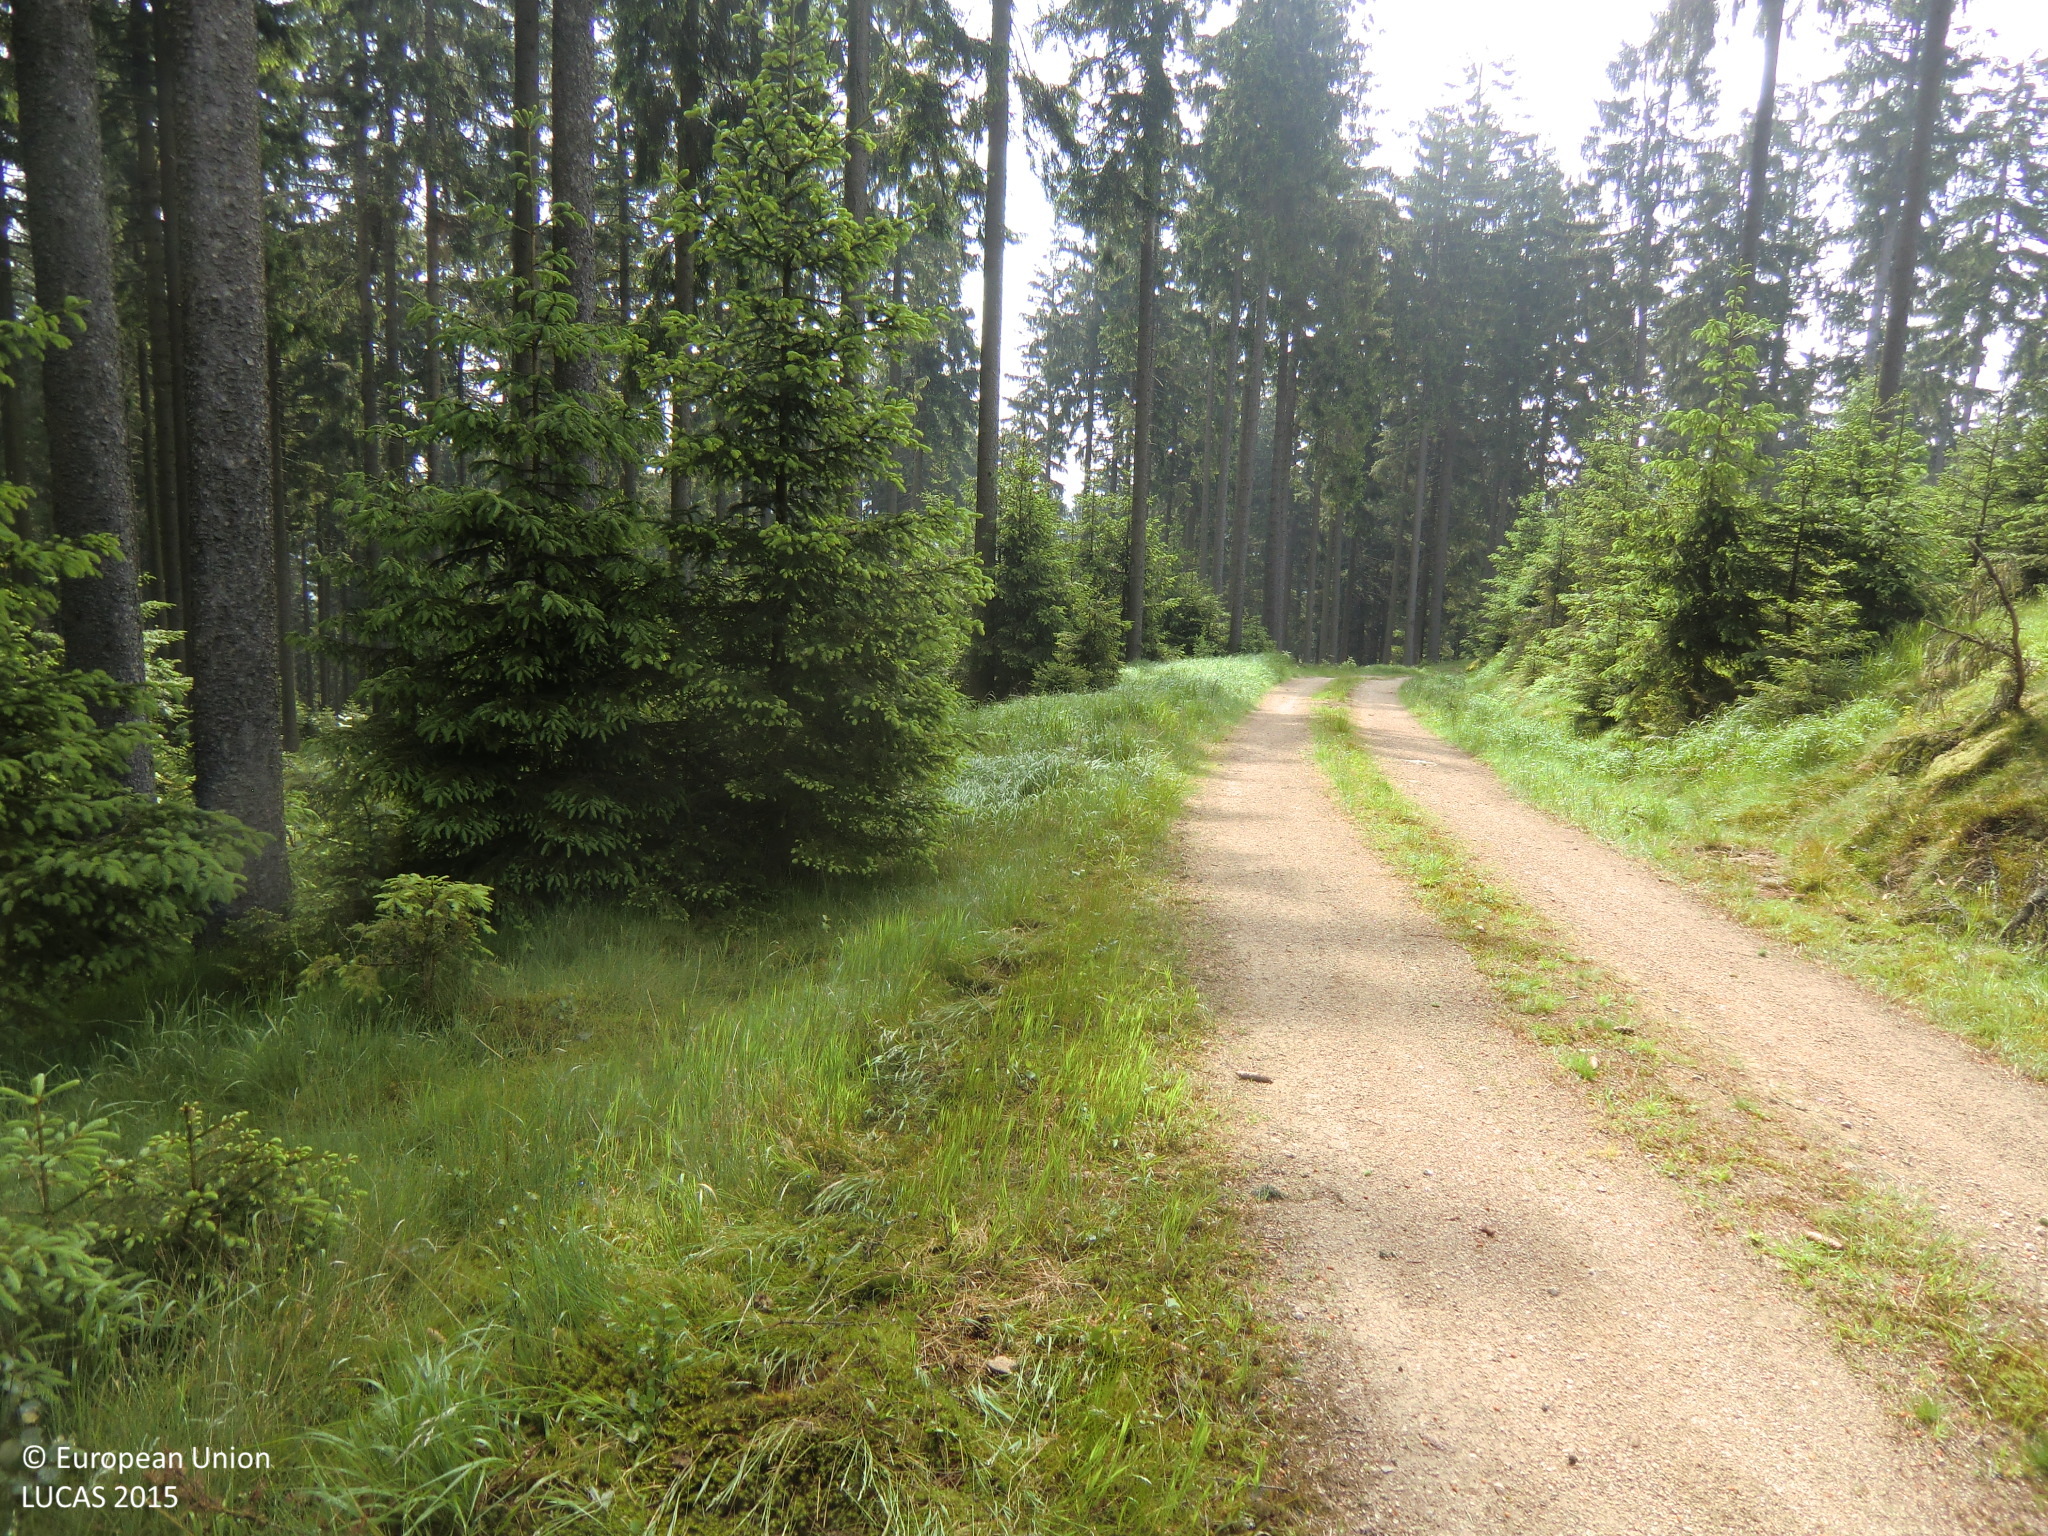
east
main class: Woodland
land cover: Other coniferous woodland
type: hemiboreal forest and nemoral coniferous forest and mixed broadleaved-coniferous forest
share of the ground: > 75 %
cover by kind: coniferous forest trees 75 %, herbaceous plants 15 %, lichens and mosses 10 %
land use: Forestry
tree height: > 5 m
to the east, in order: Tracks; Spruce dominated coniferous woodland; Tracks; Spruce dominated coniferous woodland; Tracks; Spruce dominated coniferous woodland; Tracks; Spruce dominated coniferous woodland
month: June
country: AT
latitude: 48.6085
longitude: 14.7346
